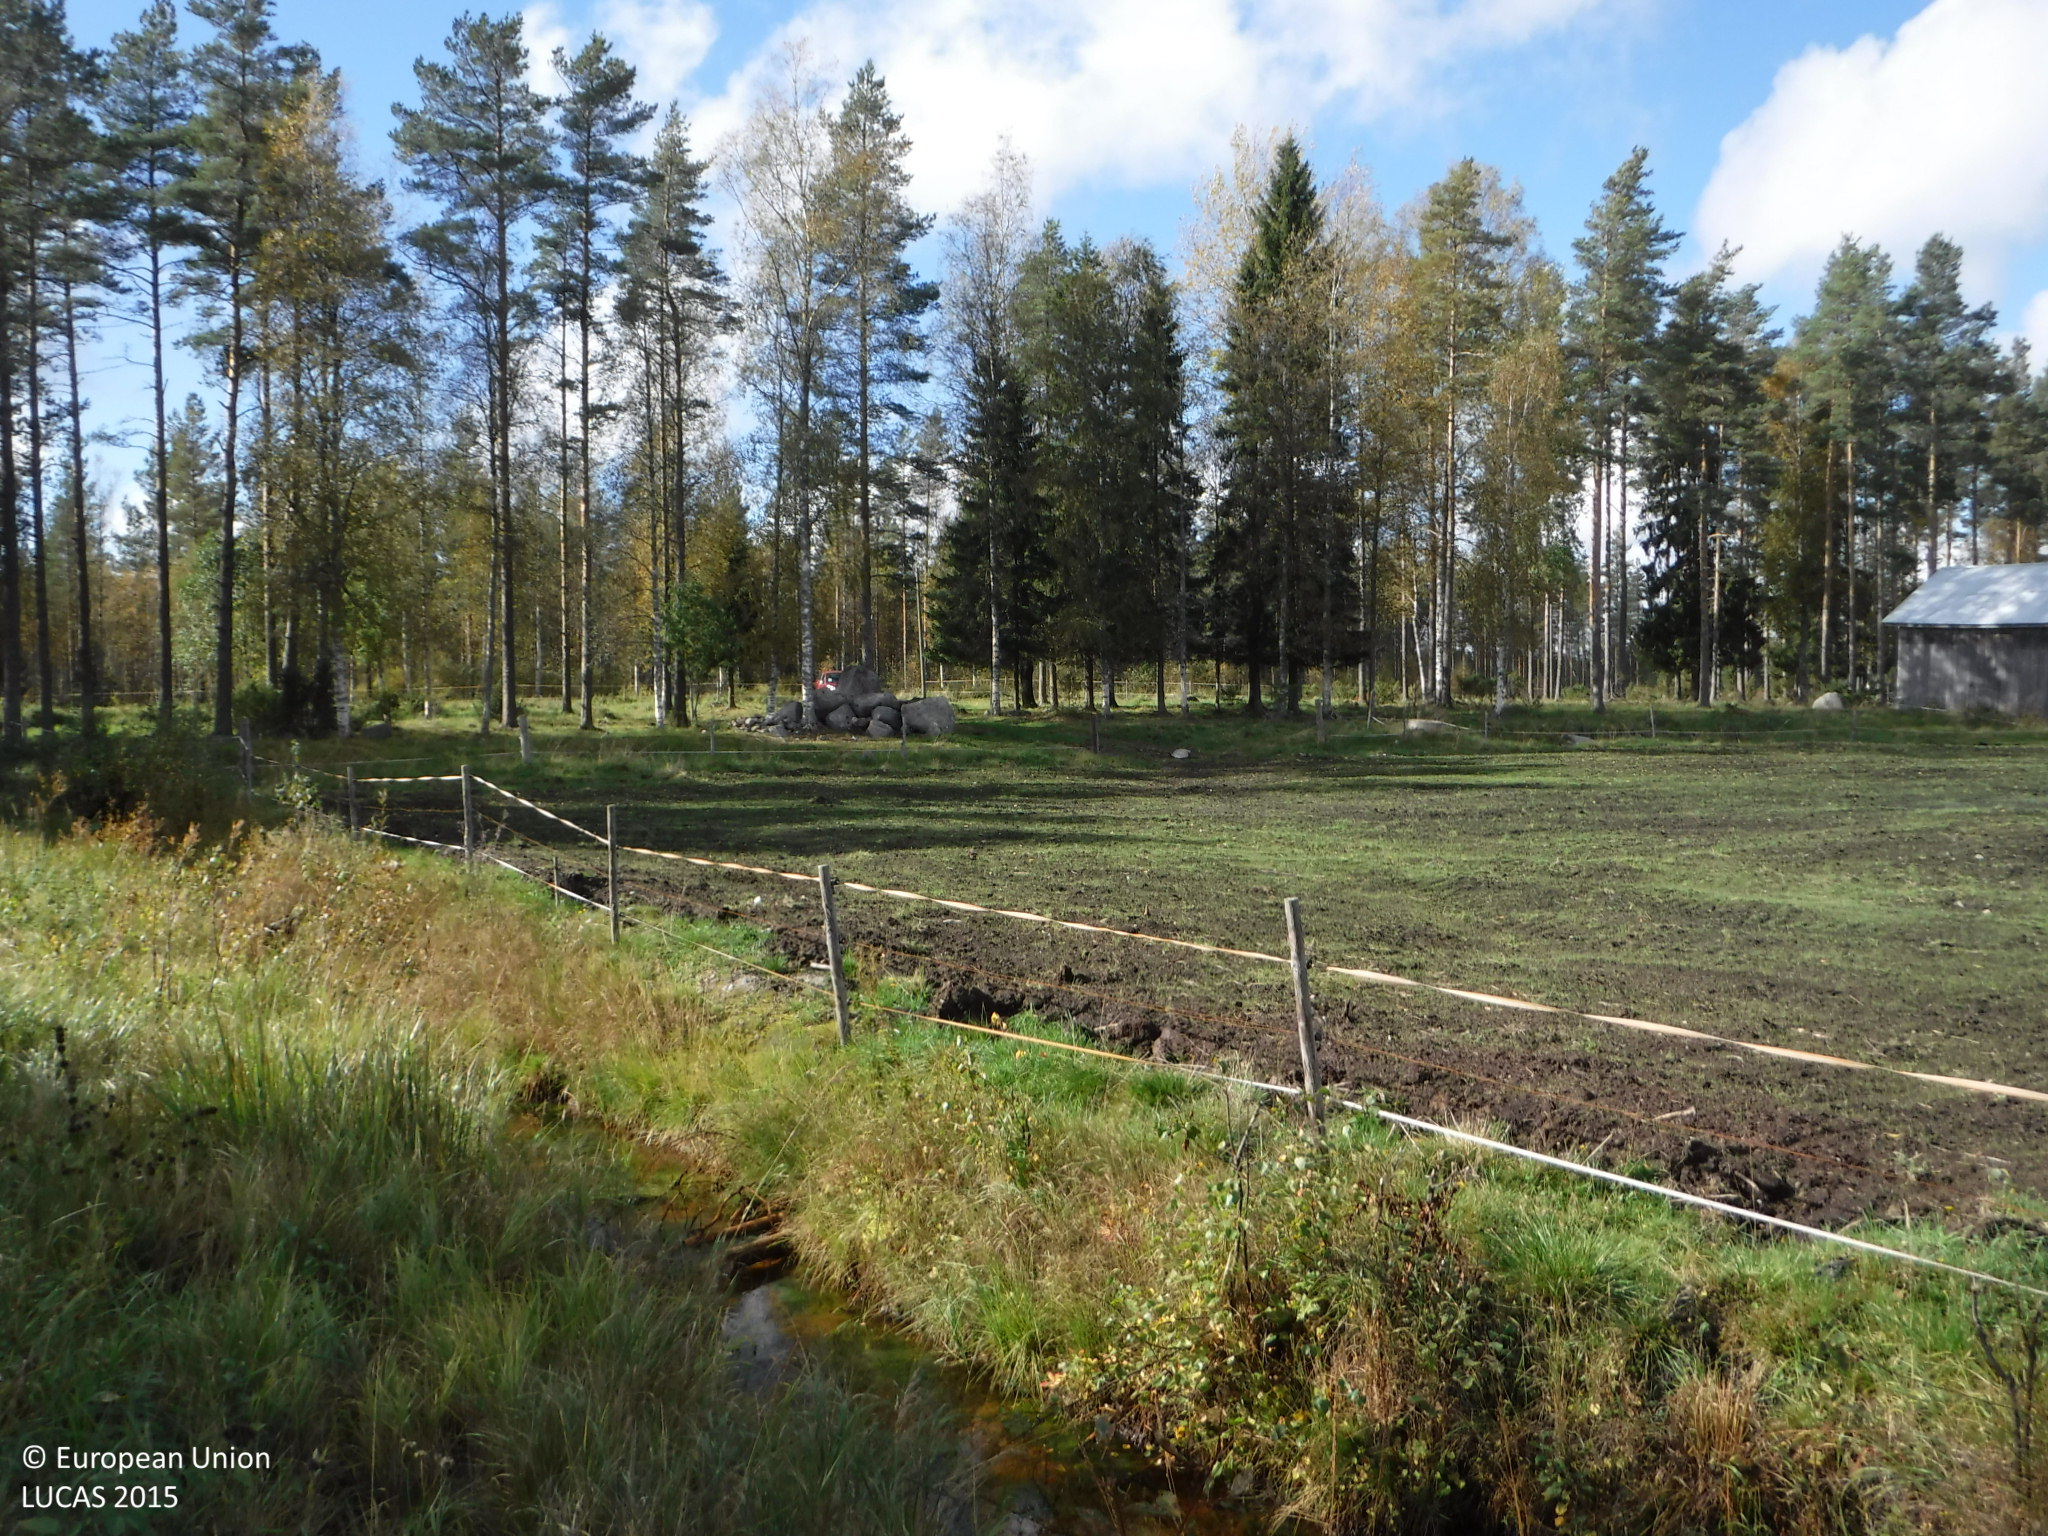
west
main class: Cropland
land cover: Temporary grasslands
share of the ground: > 75 %
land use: Agriculture (excluding fallow land and kitchen gardens)
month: September
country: FI
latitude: 62.0780
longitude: 21.7455
